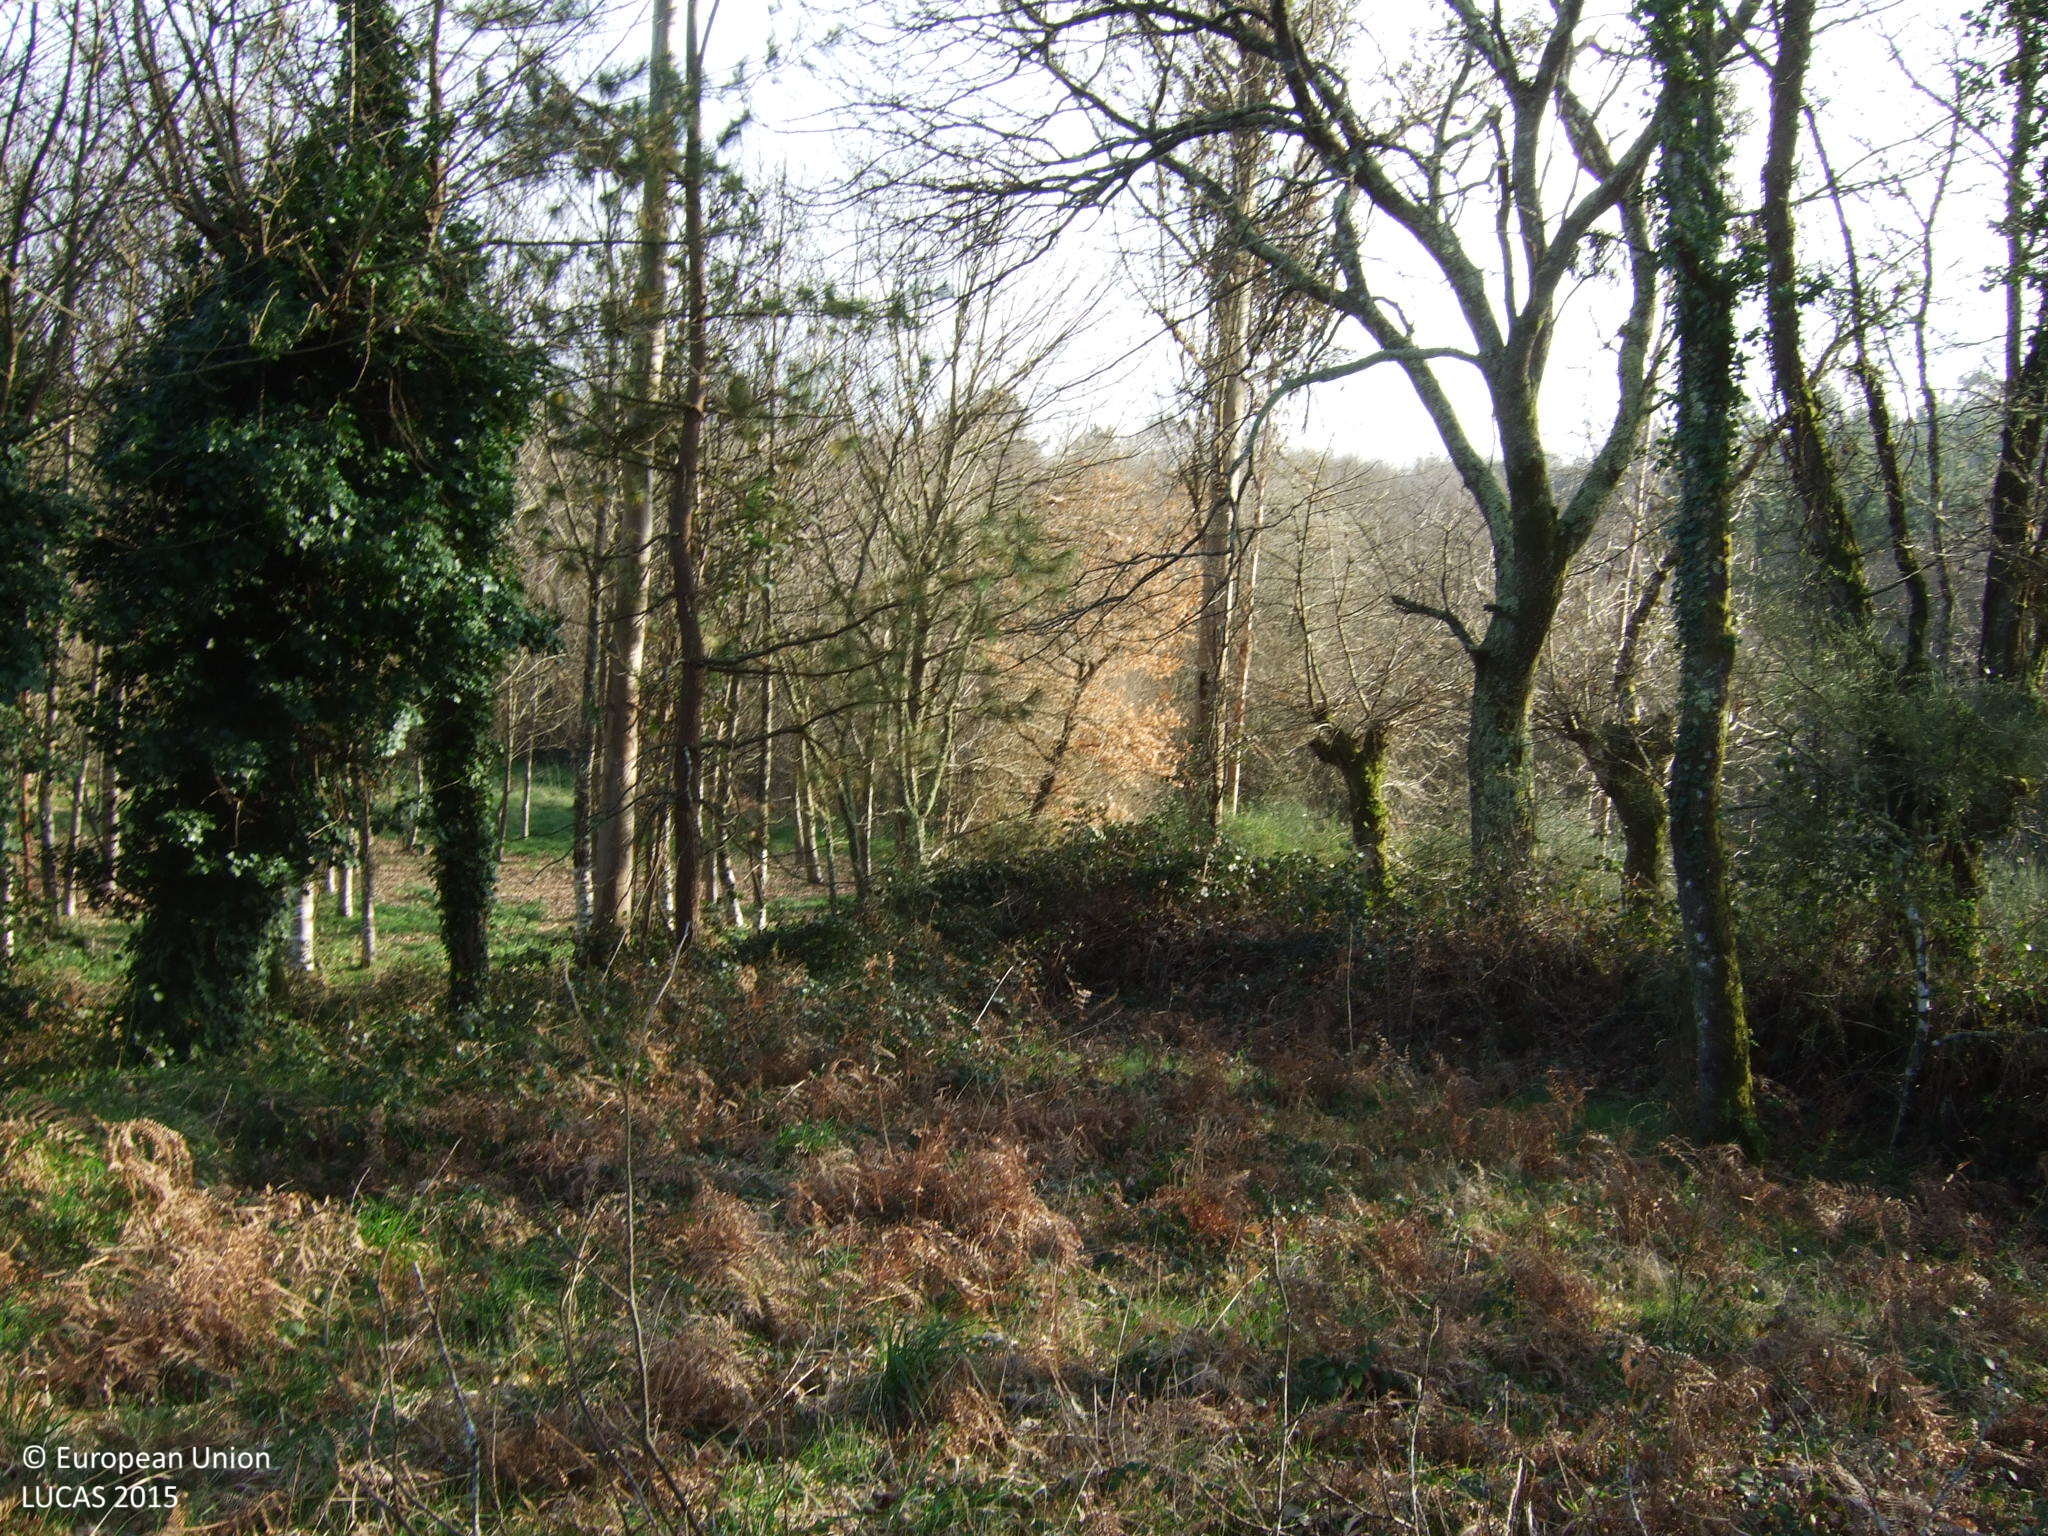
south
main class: Shrubland
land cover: Shrubland with sparse tree cover
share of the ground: > 75 %
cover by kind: shrubs 75 %, herbaceous plants 20 %, coniferous forest trees 5 %
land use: Abandoned areas
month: March
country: ES
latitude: 42.8539
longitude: -7.8907
